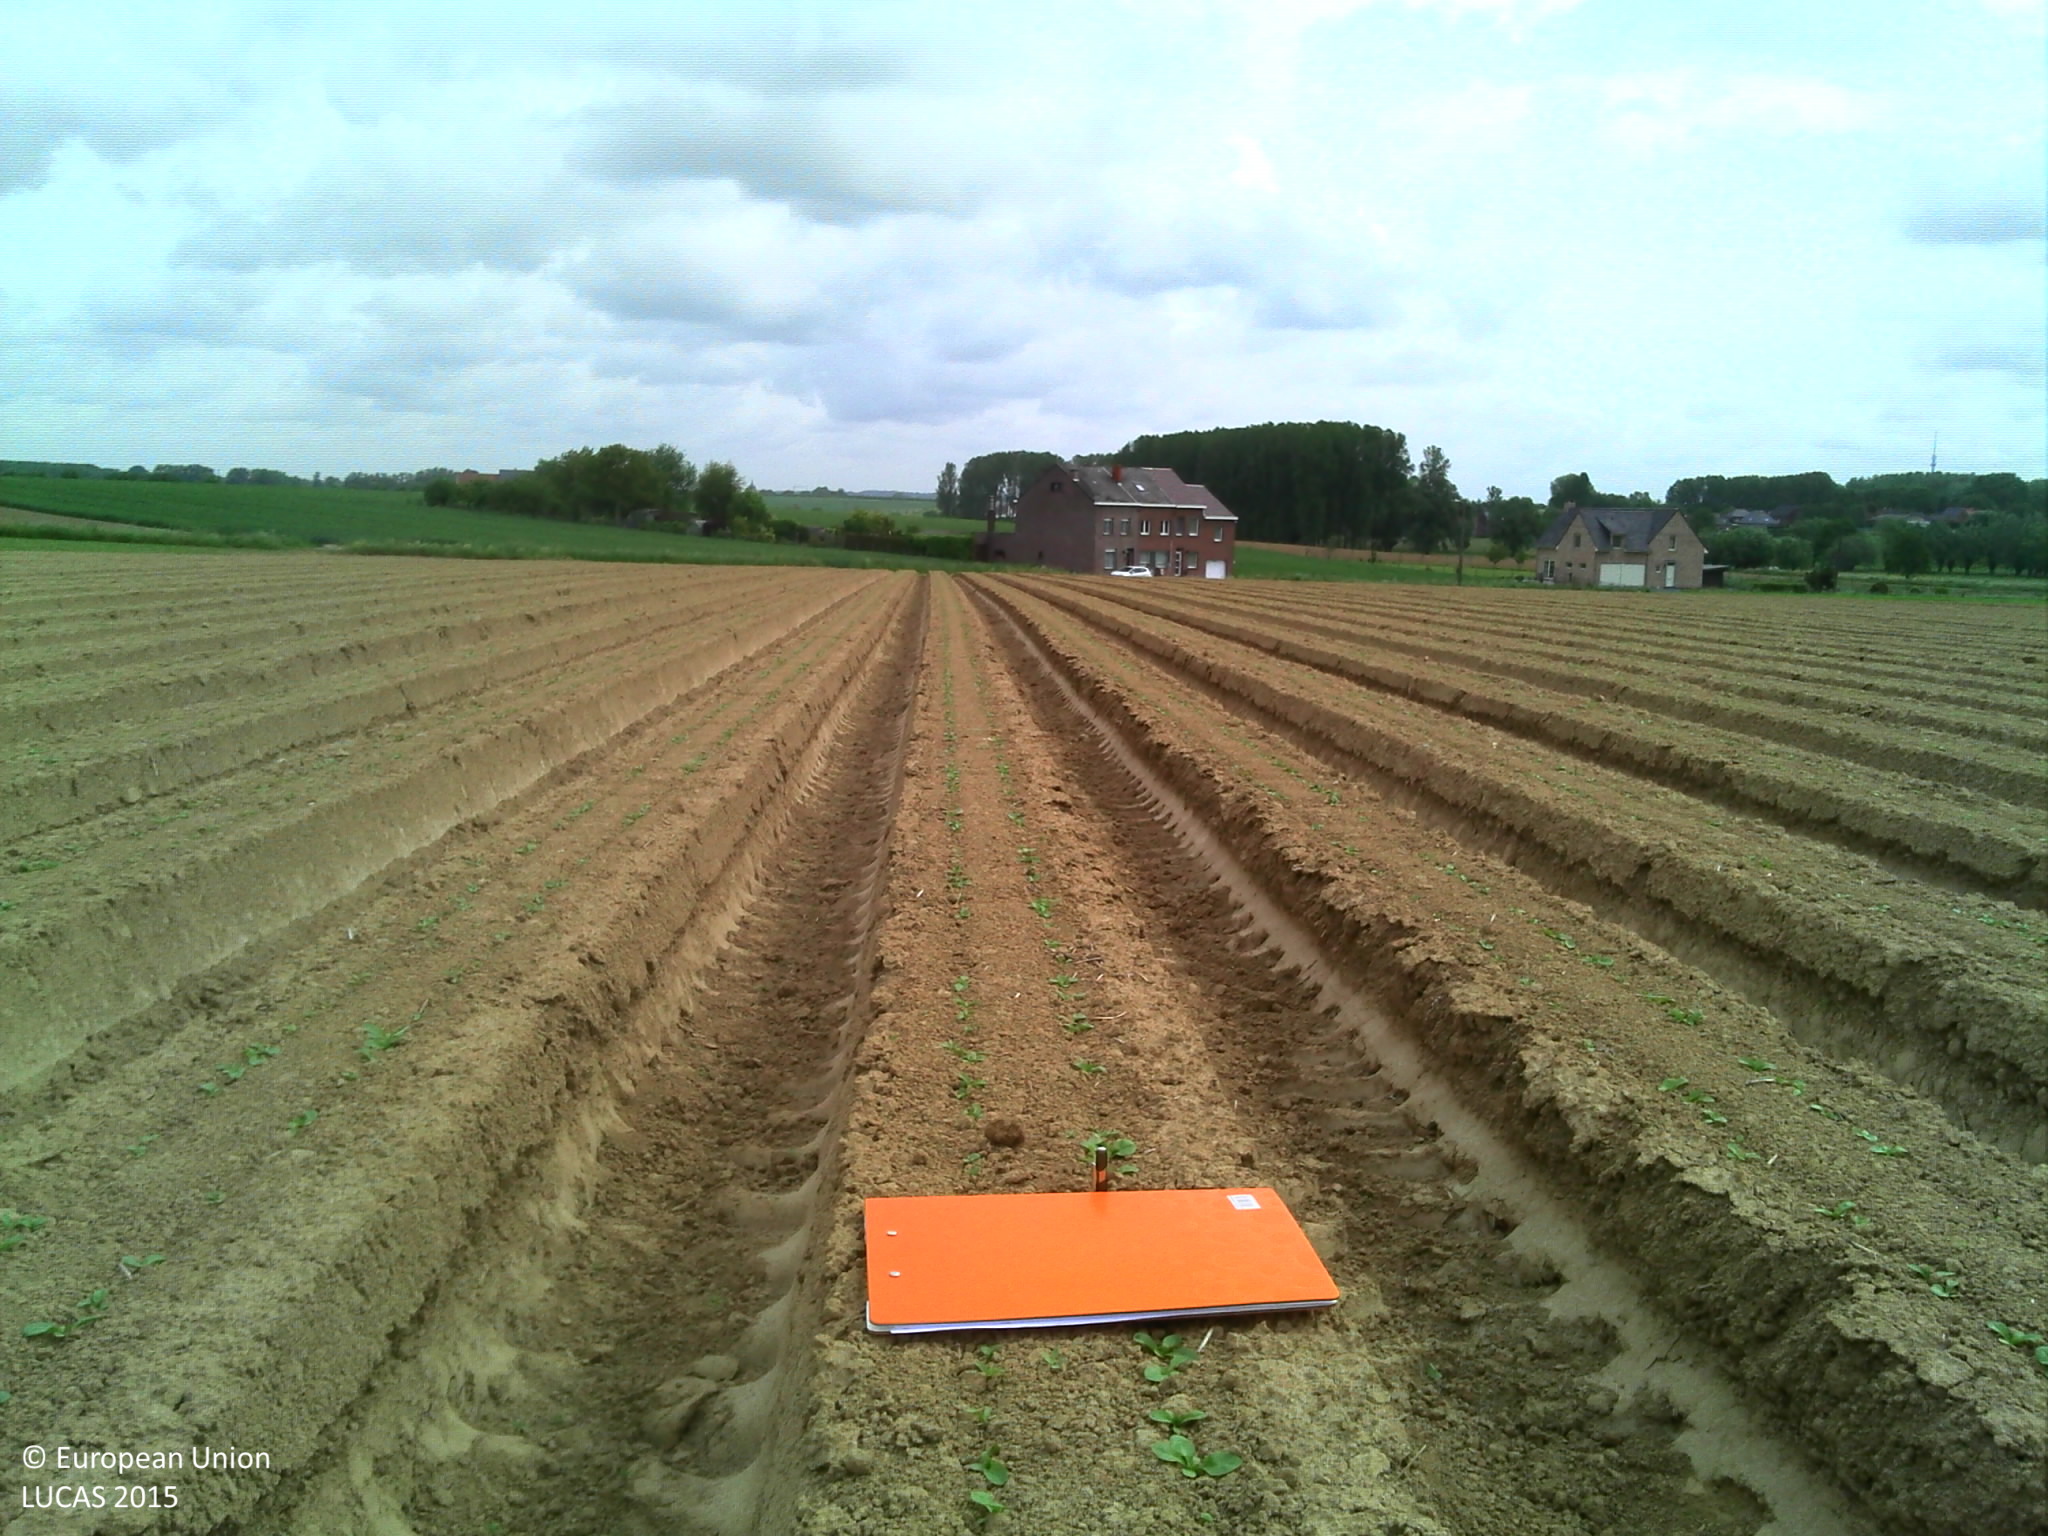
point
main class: Cropland
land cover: Other fresh vegetables
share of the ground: < 10 %
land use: Agriculture (excluding fallow land and kitchen gardens)
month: May
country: BE
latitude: 50.7368
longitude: 4.1427
